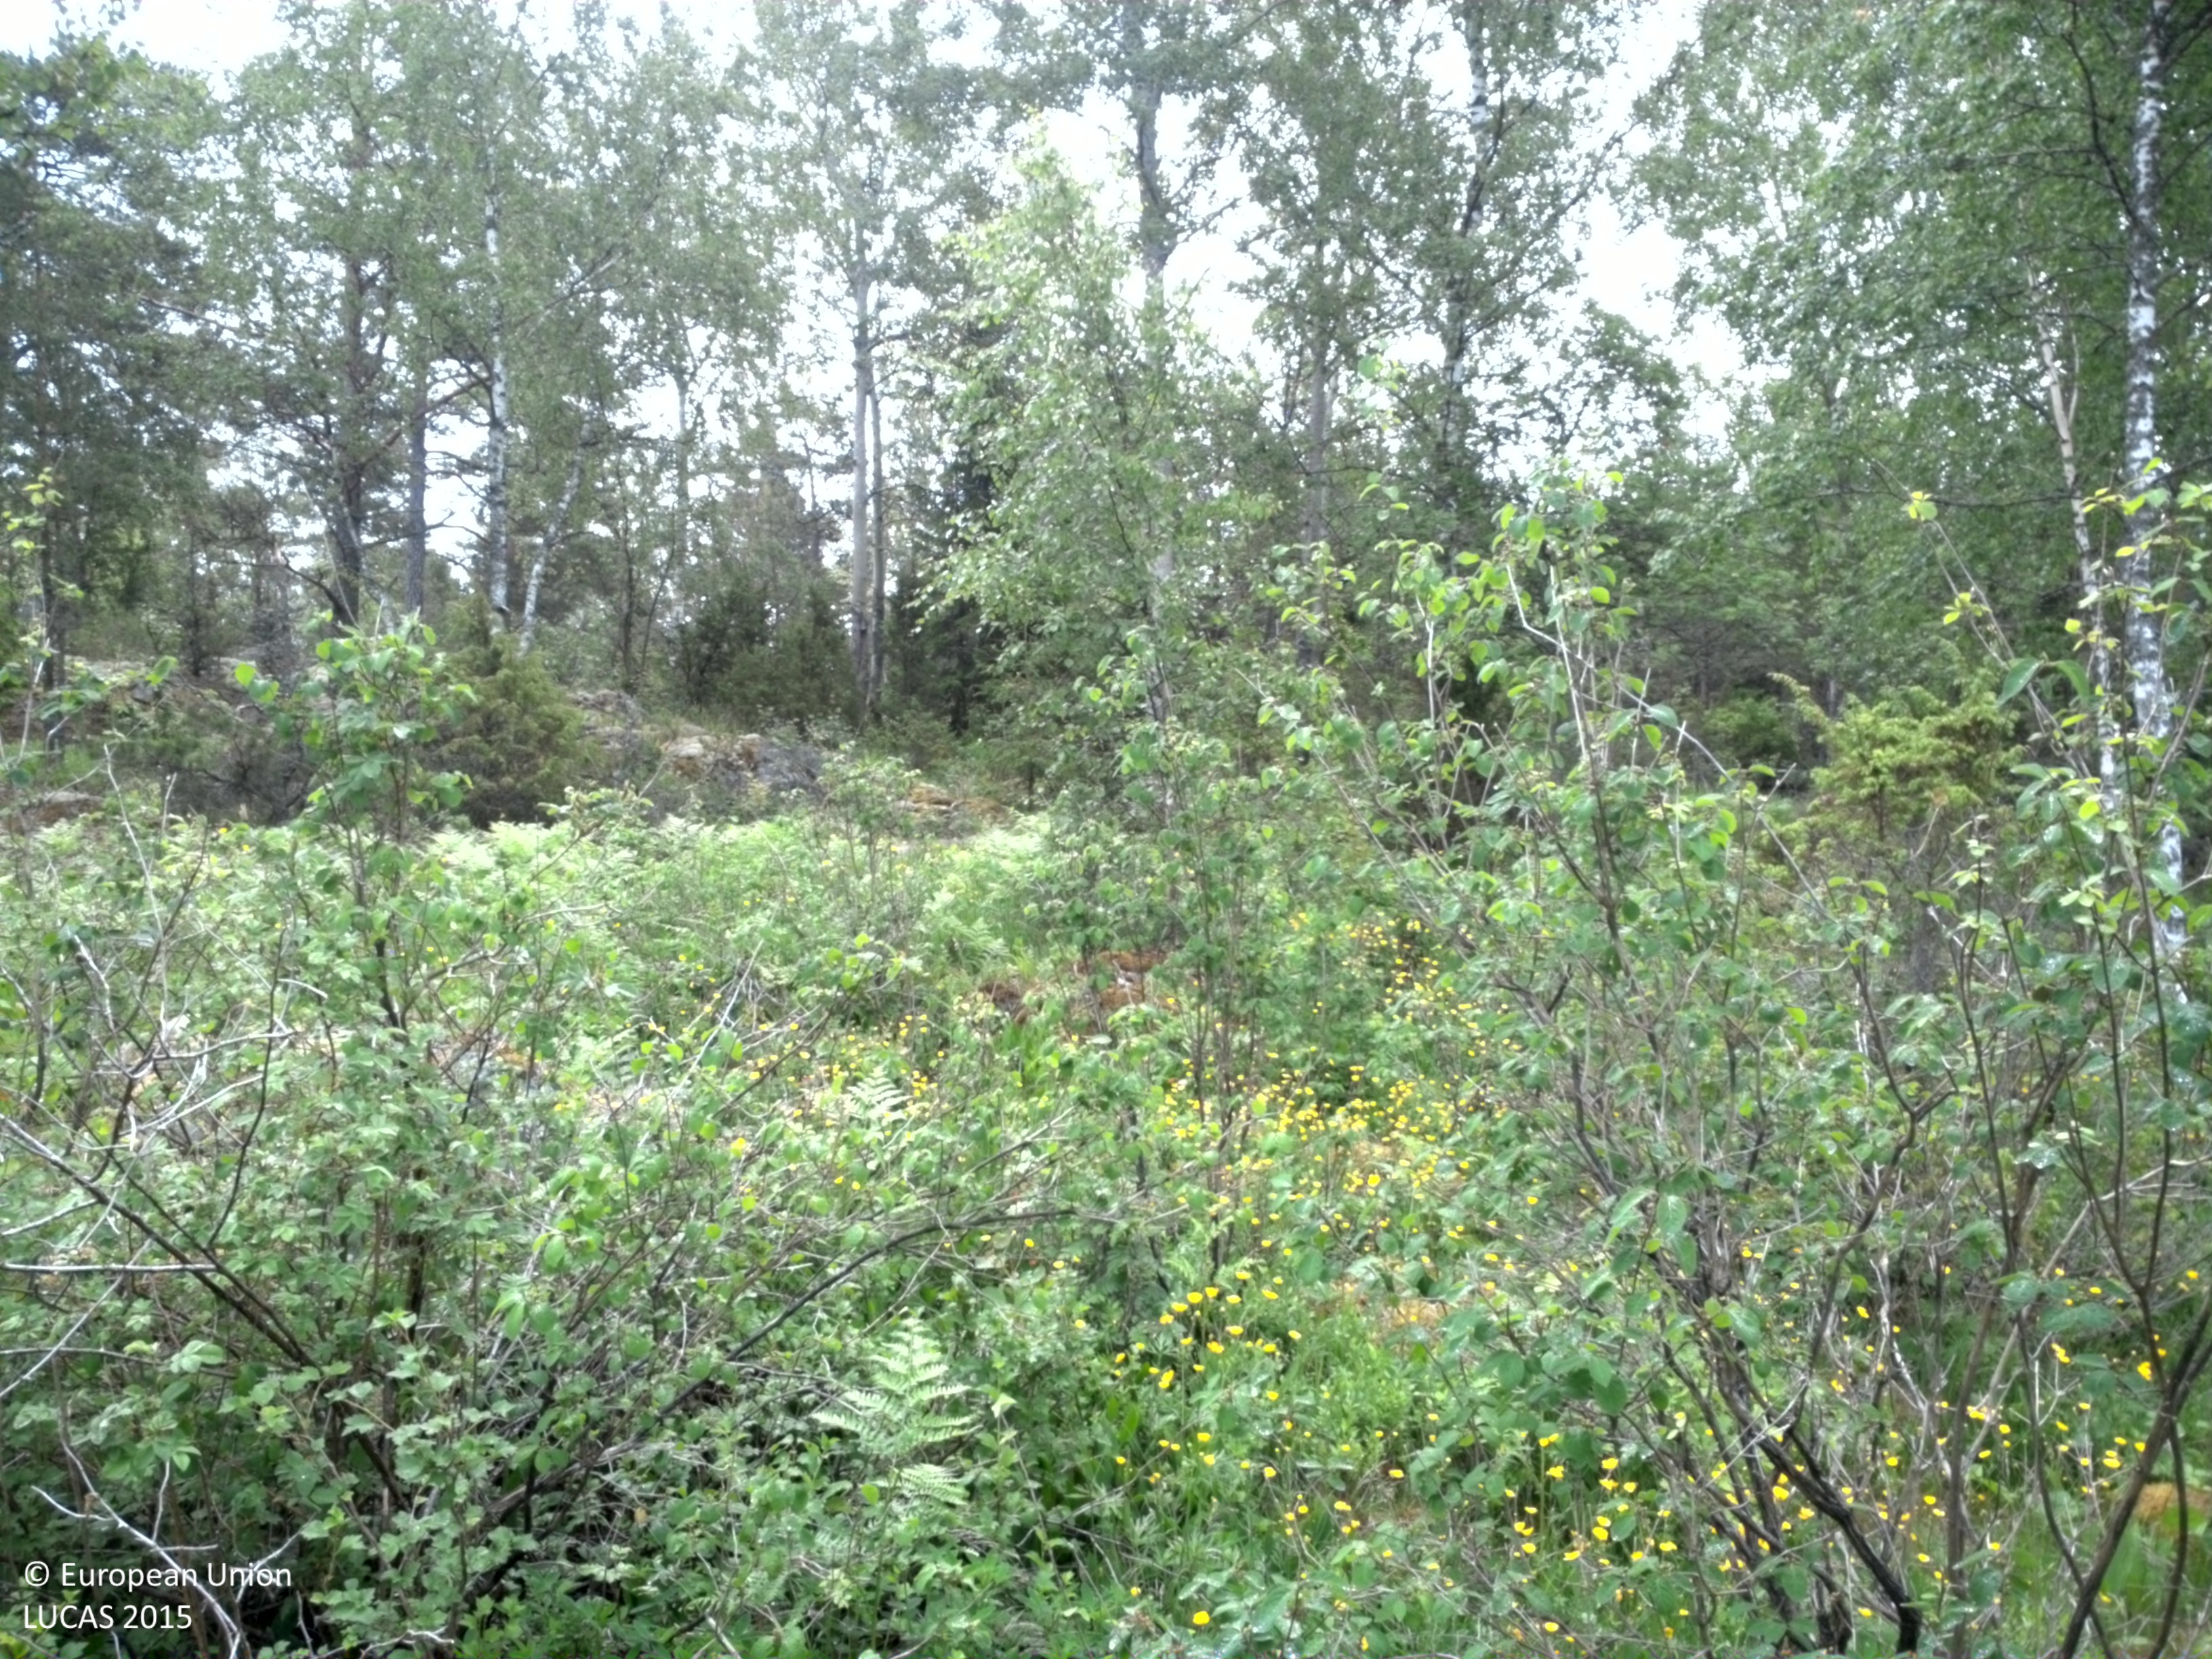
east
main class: Woodland
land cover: Broadleaved woodland
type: hemiboreal forest and nemoral coniferous forest and mixed broadleaved-coniferous forest
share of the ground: 10 - 25 %
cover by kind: herbaceous plants 50 %, broadleaved forest trees 20 %, lichens and mosses 15 %, shrubs 10 %, coniferous forest trees 5 %
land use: Forestry
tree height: > 5 m
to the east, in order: Broadleaved woodland; Pine dominated coniferous woodland; Electric lines; Spruce dominated mixed woodland; Tracks; Shrubland with sparse tree cover; Spruce dominated mixed woodland; Tracks; Pine dominated coniferous woodland
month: June
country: SE
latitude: 60.0159
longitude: 18.7711
